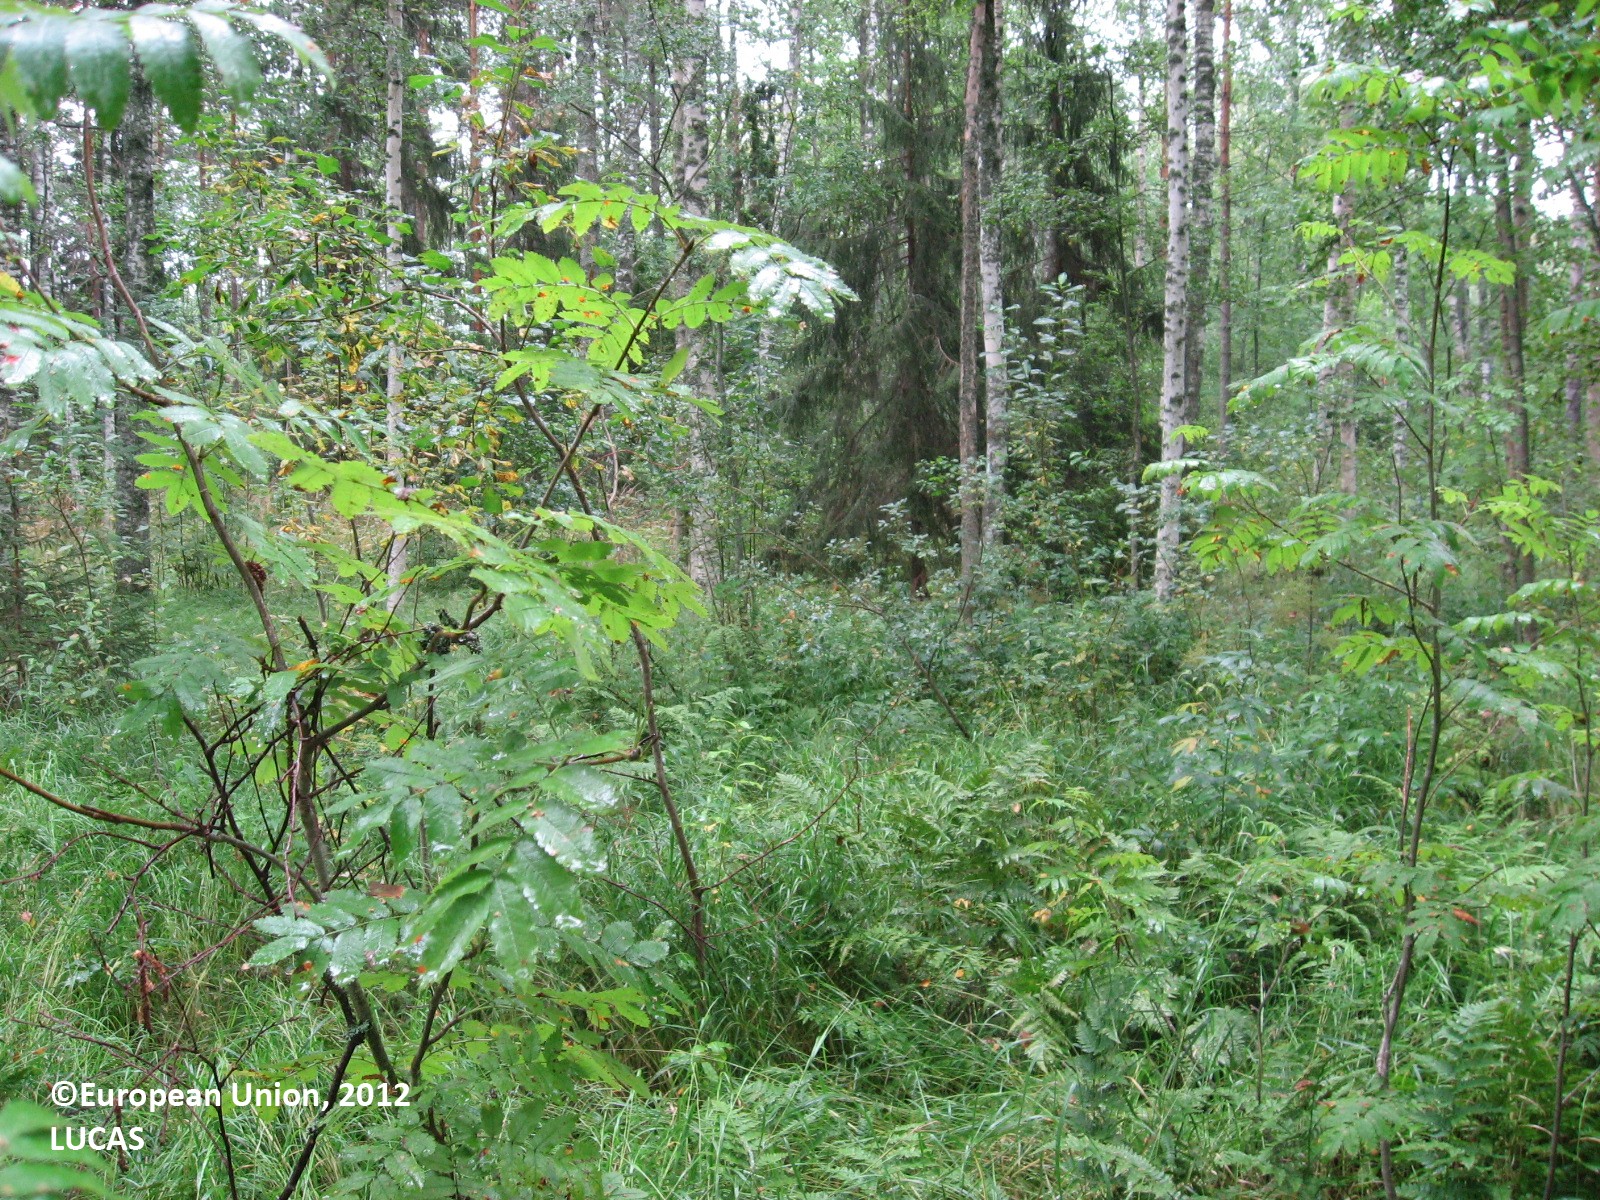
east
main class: Woodland
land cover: Other mixed woodland
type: boreal forest
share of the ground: 50 - 75 %
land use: Forestry
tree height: > 5 m
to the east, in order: Other mixed woodland; Pine dominated mixed woodland; Paved roads, cycling and walking lanes; Other mixed woodland; Oats; Grass margins; Rivers and streams; Grass margins; Oats; Grass margins; Ditches and canals; Other mixed woodland; Grass margins; Ditches and canals; Grass margins; Oats; Grass margins; Electric lines; Grass margins; Paved roads, cycling and walking lanes; Artificial constructions in urban areas; Pine dominated mixed woodland
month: August
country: FI
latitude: 61.3298
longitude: 24.7351
